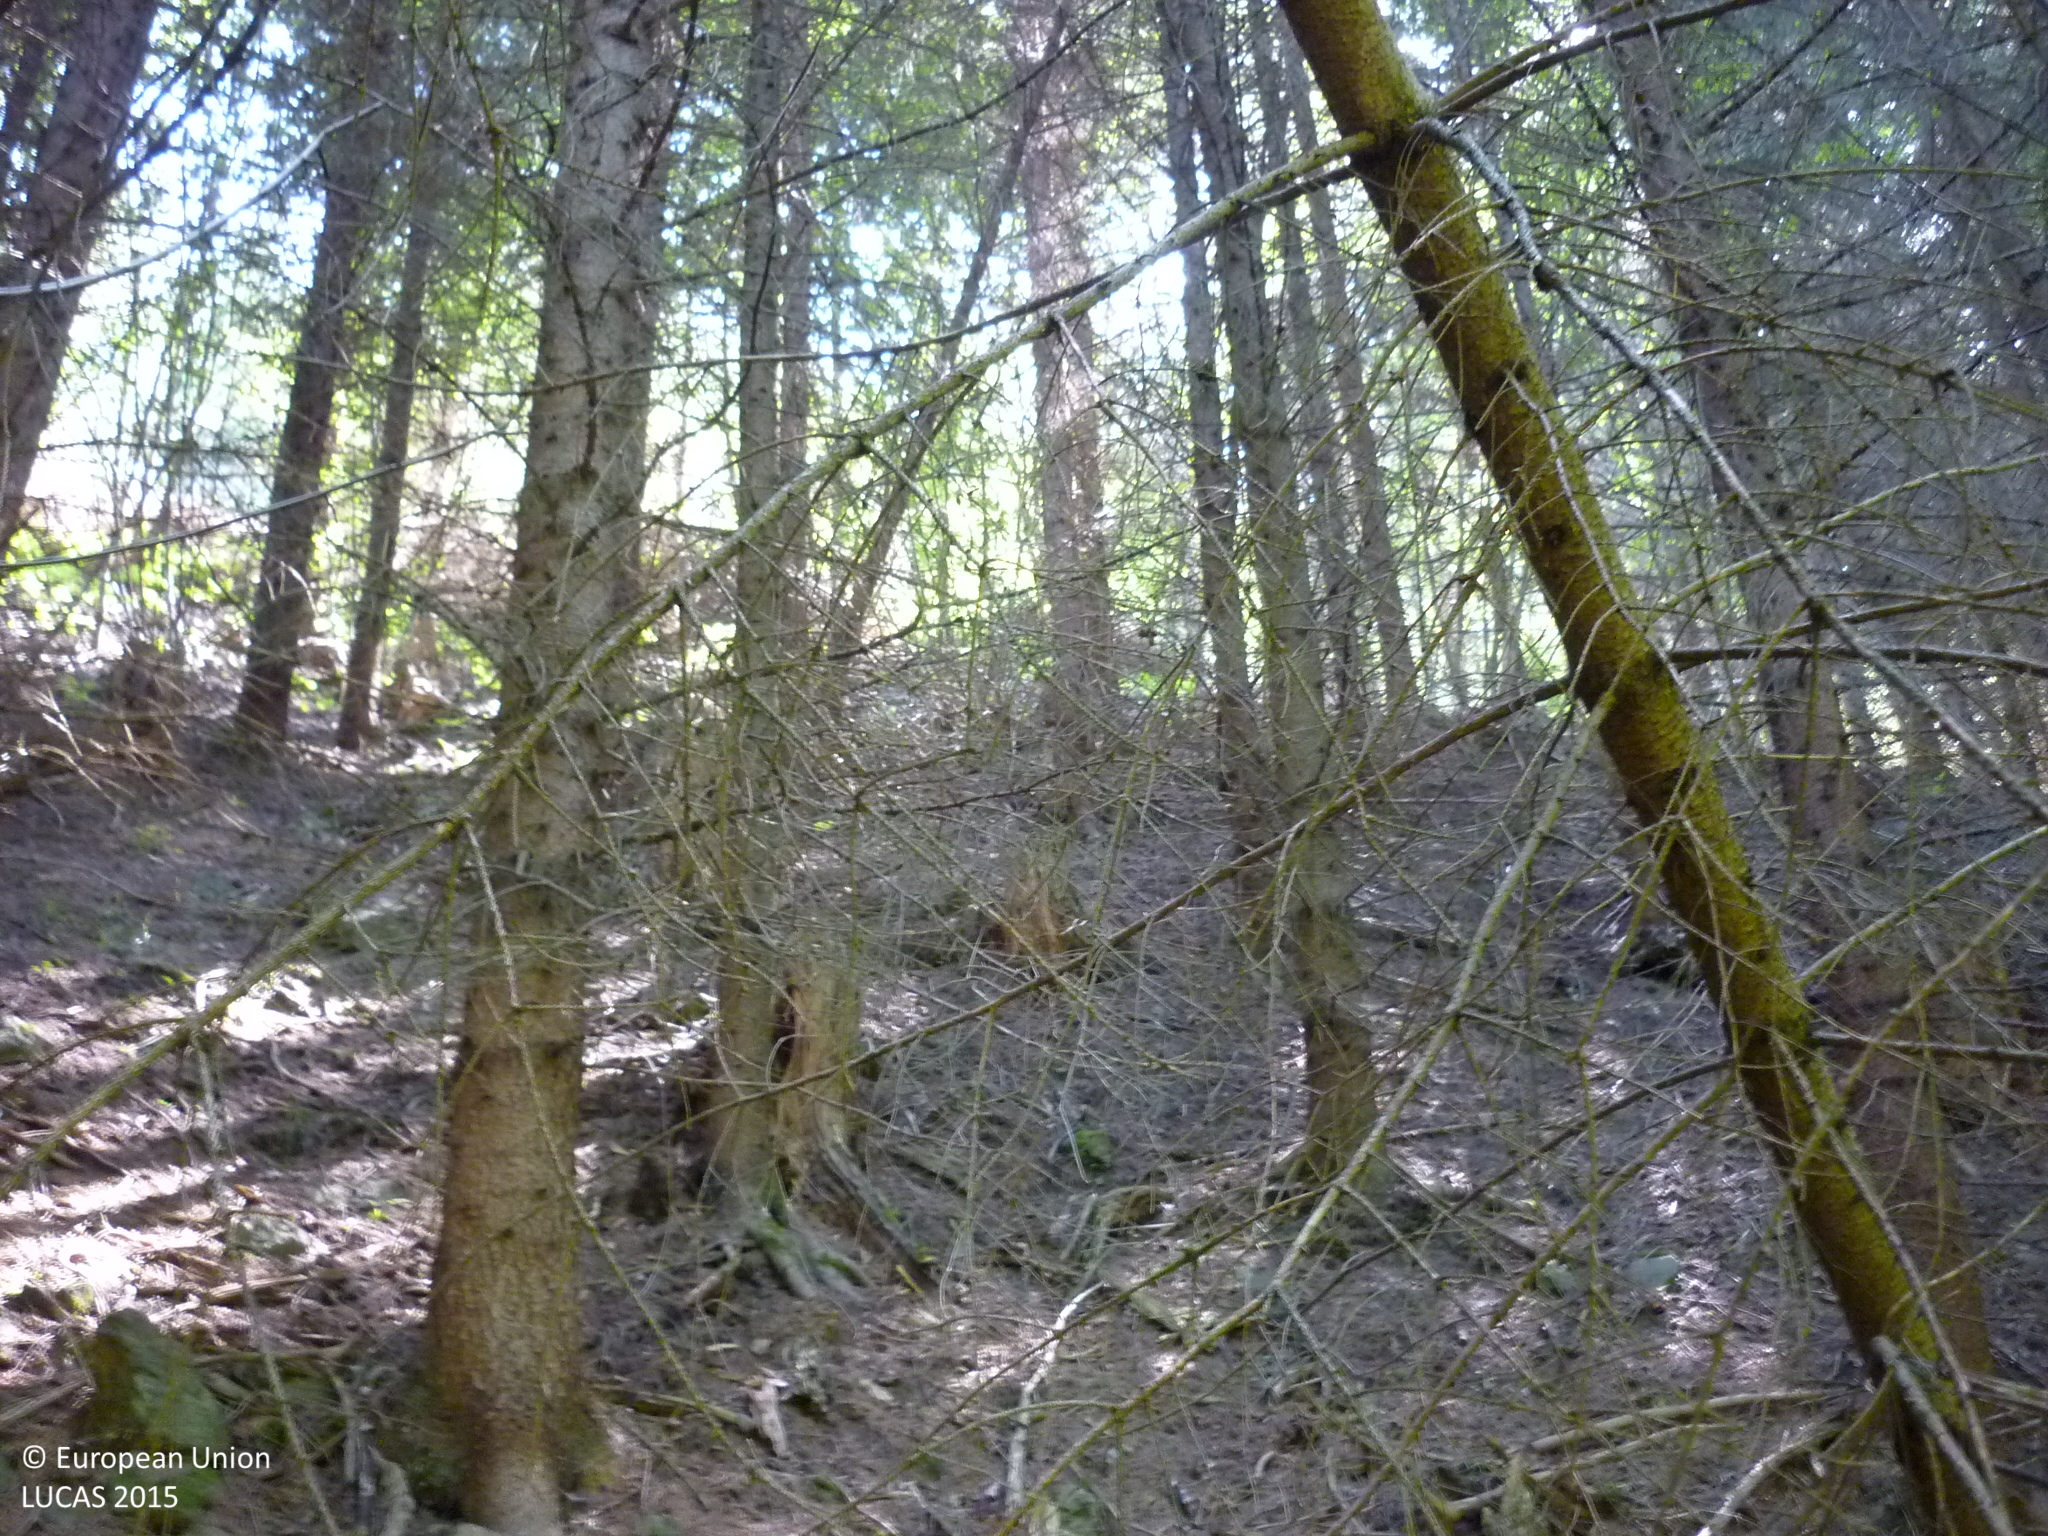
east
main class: Woodland
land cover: Spruce dominated coniferous woodland
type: alpine coniferous forest
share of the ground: > 75 %
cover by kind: coniferous forest trees 85 %, shrubs 15 %
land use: Forestry
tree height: > 5 m
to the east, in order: Spruce dominated coniferous woodland; Tracks; Spontaneously vegetated surfaces; Spruce dominated coniferous woodland; Spontaneously vegetated surfaces
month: May
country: AT
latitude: 47.3006
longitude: 14.9590
